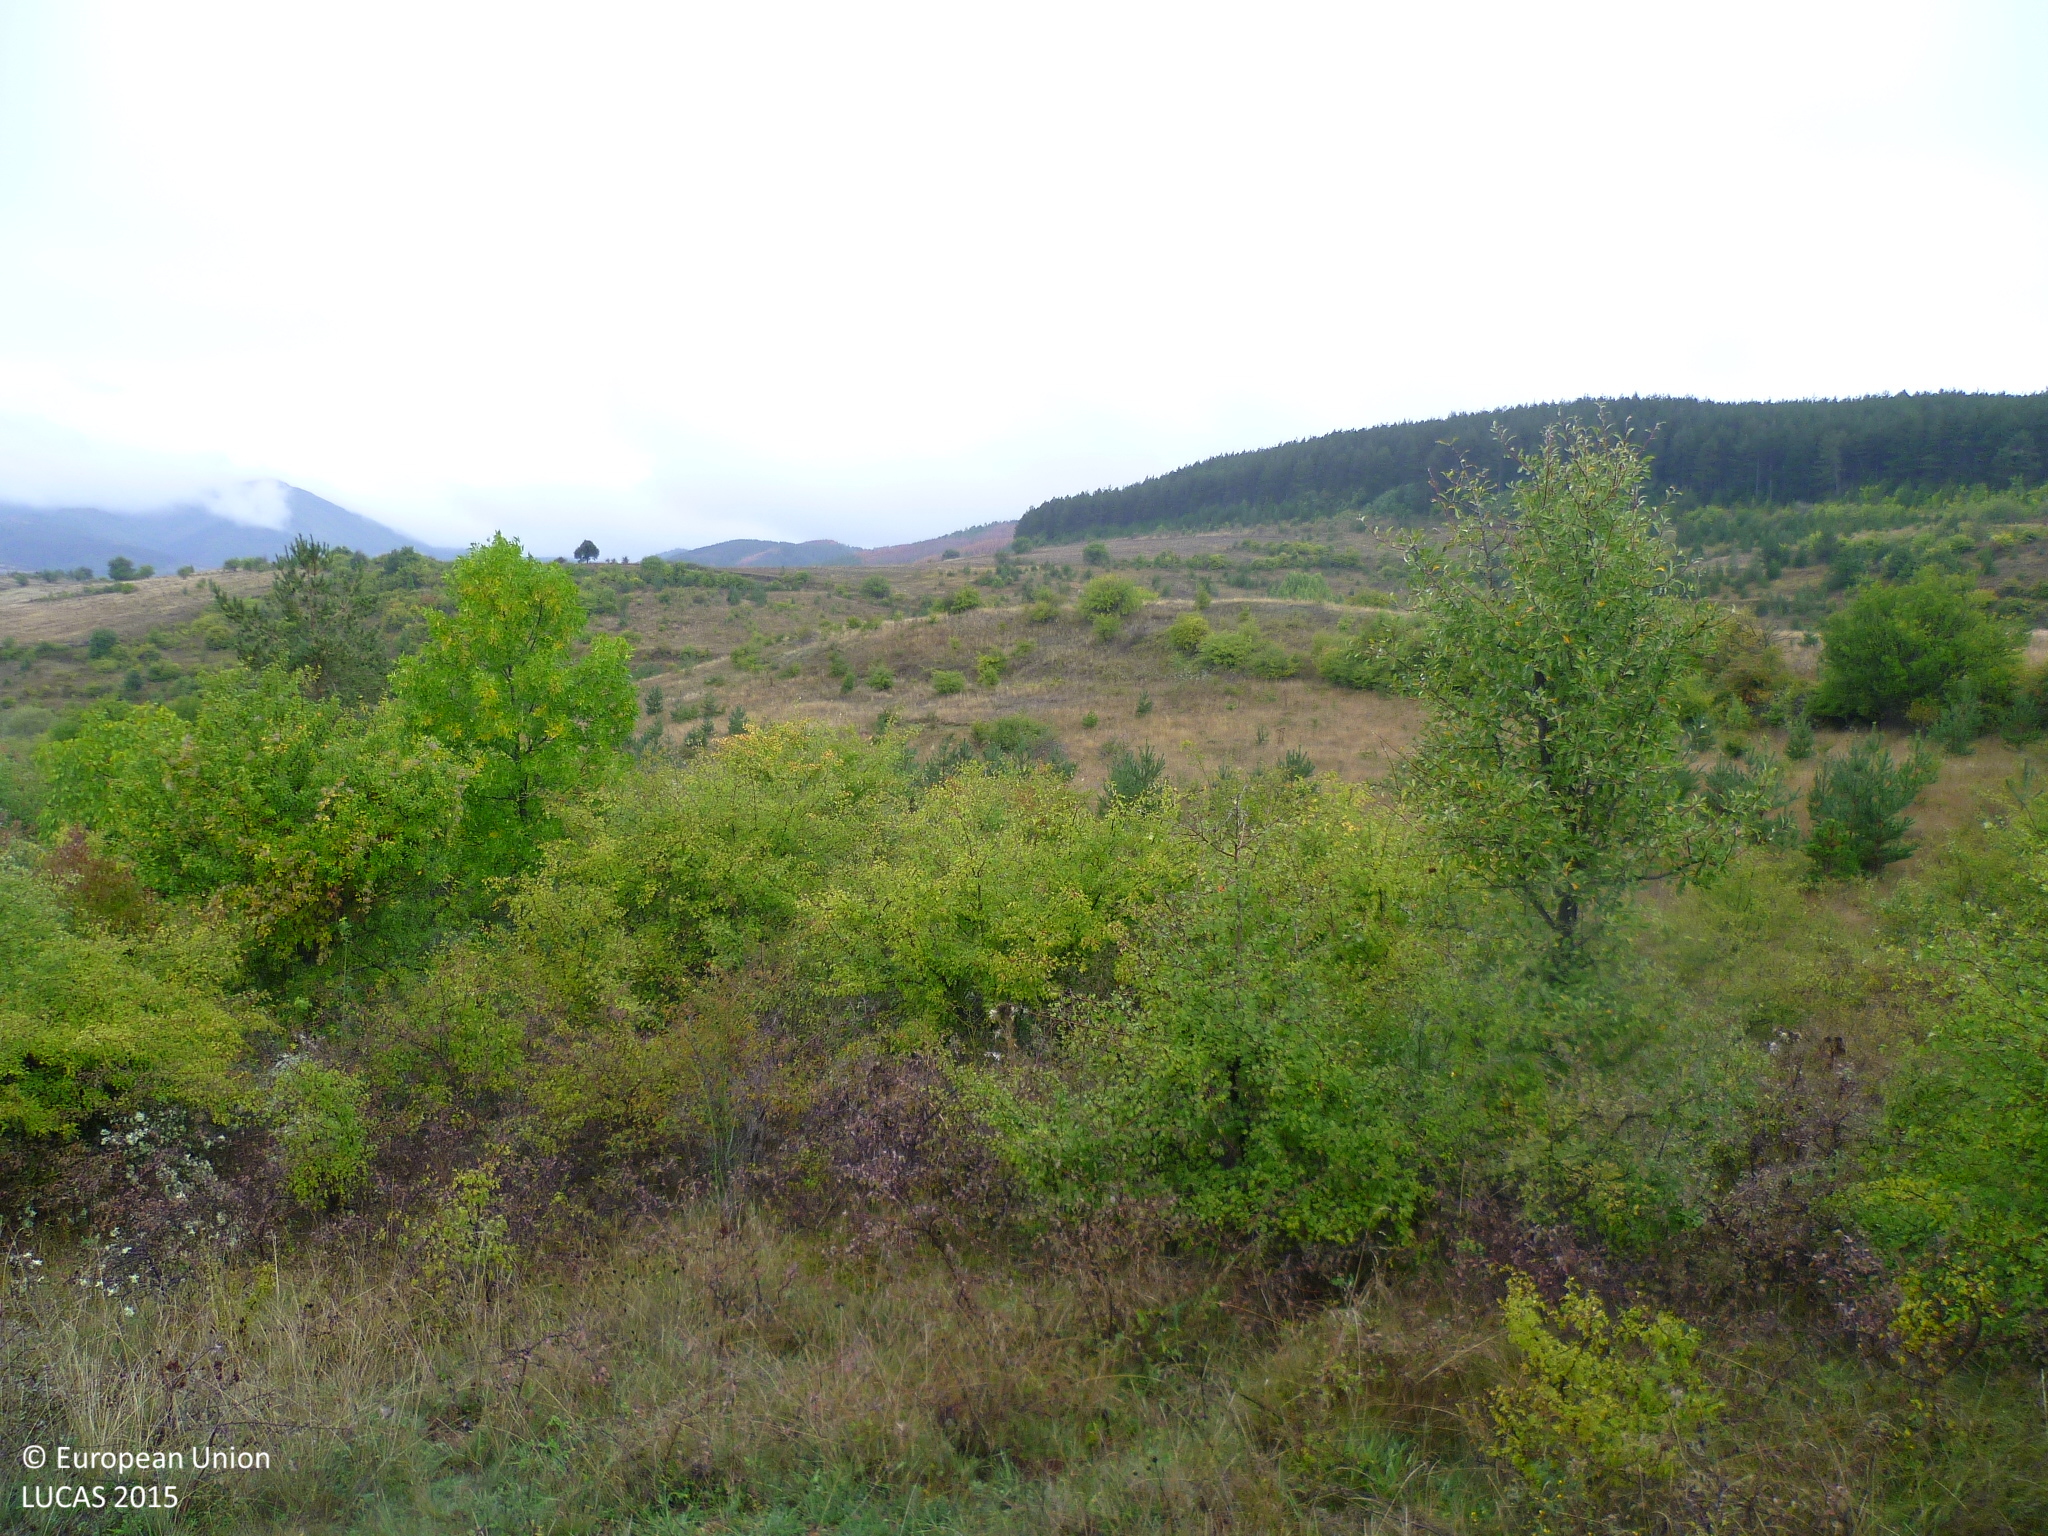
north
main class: Grassland
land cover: Grassland with sparse tree/shrub cover
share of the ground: > 75 %
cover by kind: herbaceous plants 90 %, broadleaved forest trees 5 %, shrubs 5 %
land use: Agriculture (excluding fallow land and kitchen gardens)
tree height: < 5 m
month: September
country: BG
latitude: 42.6838
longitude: 22.7555
